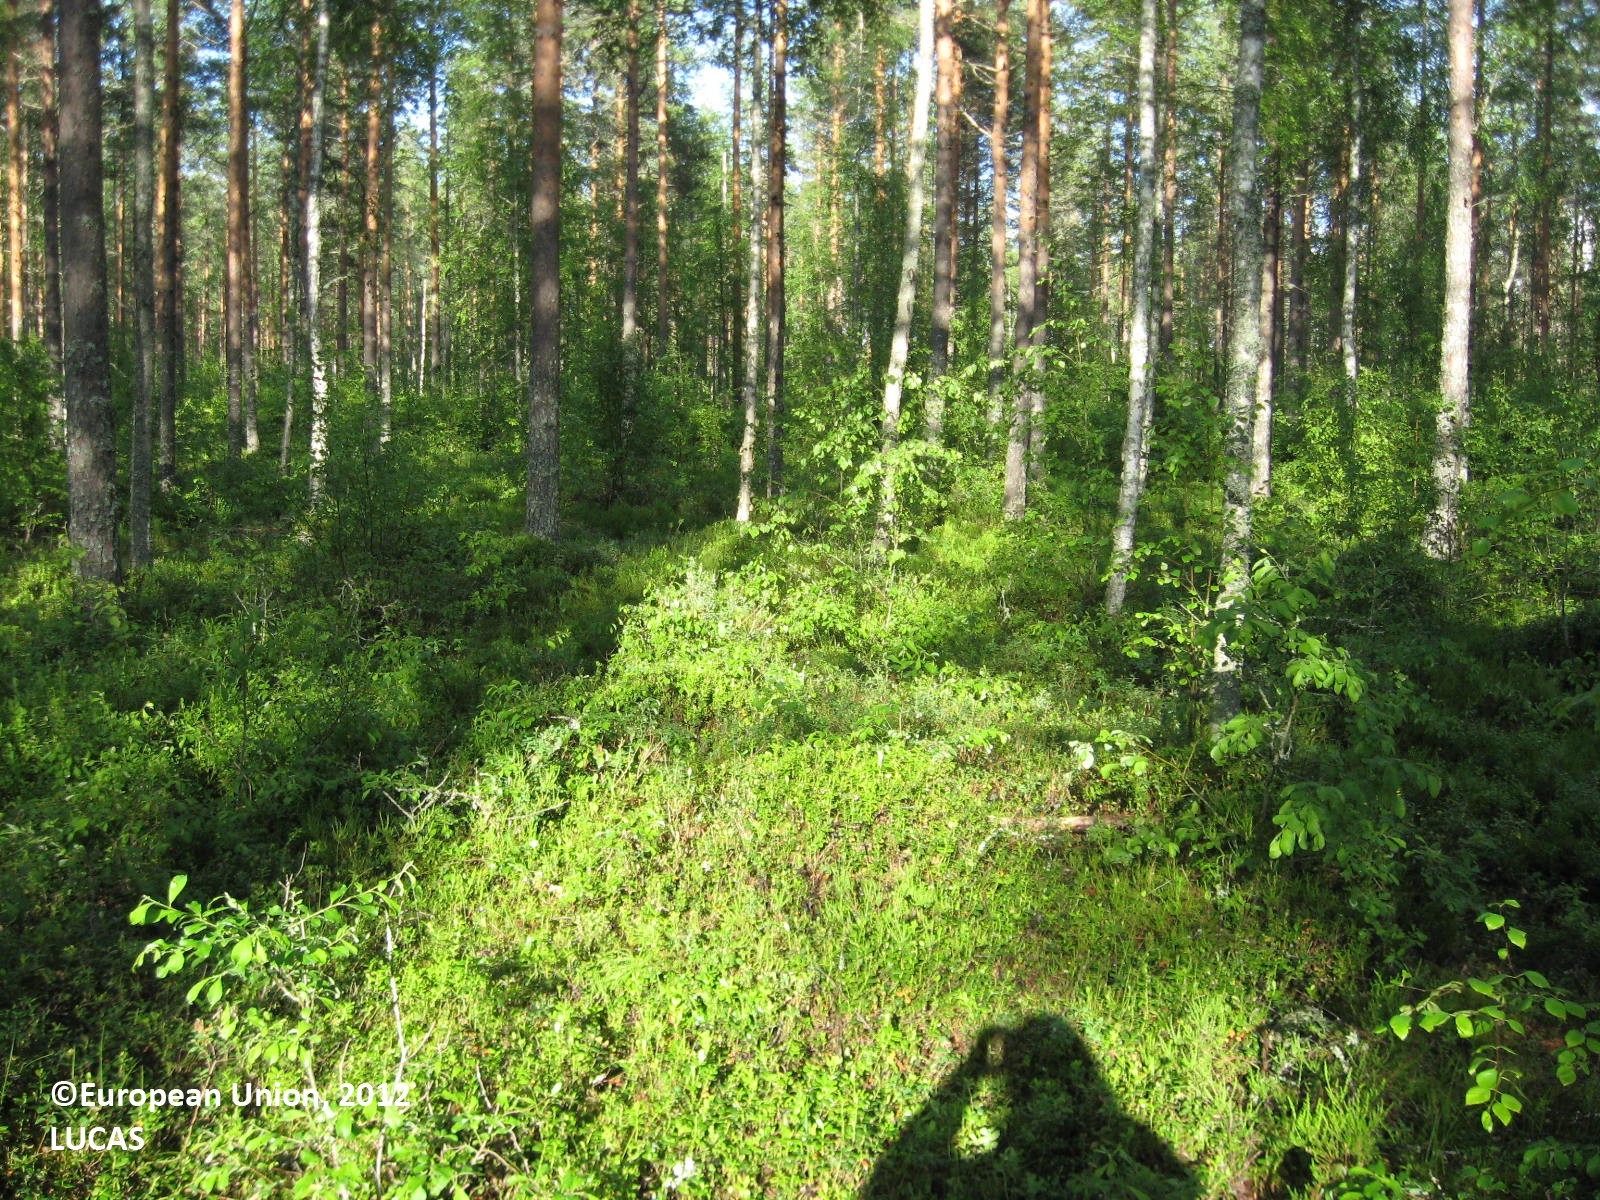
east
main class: Woodland
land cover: Pine dominated mixed woodland
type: boreal forest
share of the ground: > 75 %
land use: Forestry
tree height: > 5 m
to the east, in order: Pine dominated mixed woodland; Ditches and canals; Pine dominated coniferous woodland; Ditches and canals; Pine dominated coniferous woodland; Ditches and canals; Pine dominated mixed woodland; Ditches and canals; Other mixed woodland; Ditches and canals; Other mixed woodland; Ditches and canals; Pine dominated mixed woodland; Ditches and canals; Pine dominated mixed woodland
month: July
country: FI
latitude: 62.2702
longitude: 22.5220
